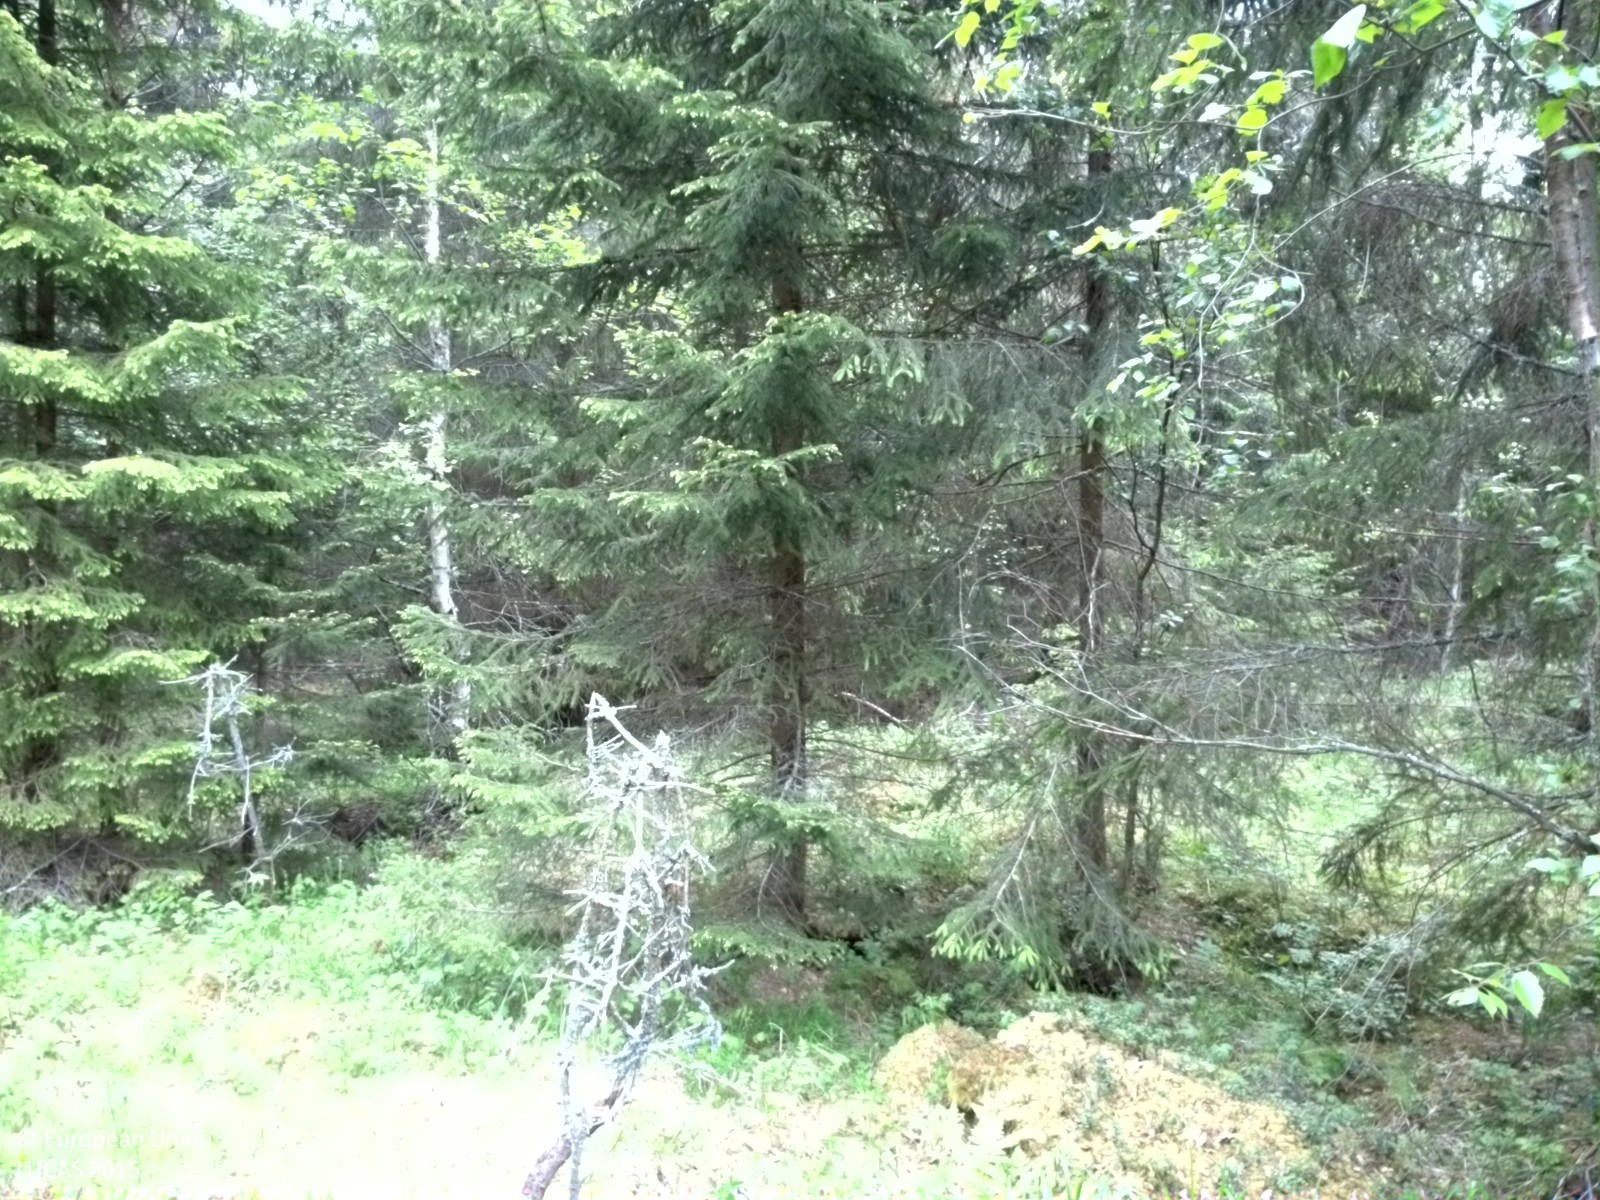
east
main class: Woodland
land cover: Spruce dominated coniferous woodland
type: boreal forest
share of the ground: 50 - 75 %
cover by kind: coniferous forest trees 45 %, herbaceous plants 20 %, broadleaved forest trees 15 %, shrubs 5 %, lichens and mosses 5 %
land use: Forestry
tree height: > 5 m
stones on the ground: 10 - 25 %
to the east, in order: Spruce dominated coniferous woodland; Rivers and streams; Other coniferous woodland; Pine dominated coniferous woodland
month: June
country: SE
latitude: 60.2912
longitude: 17.0998
